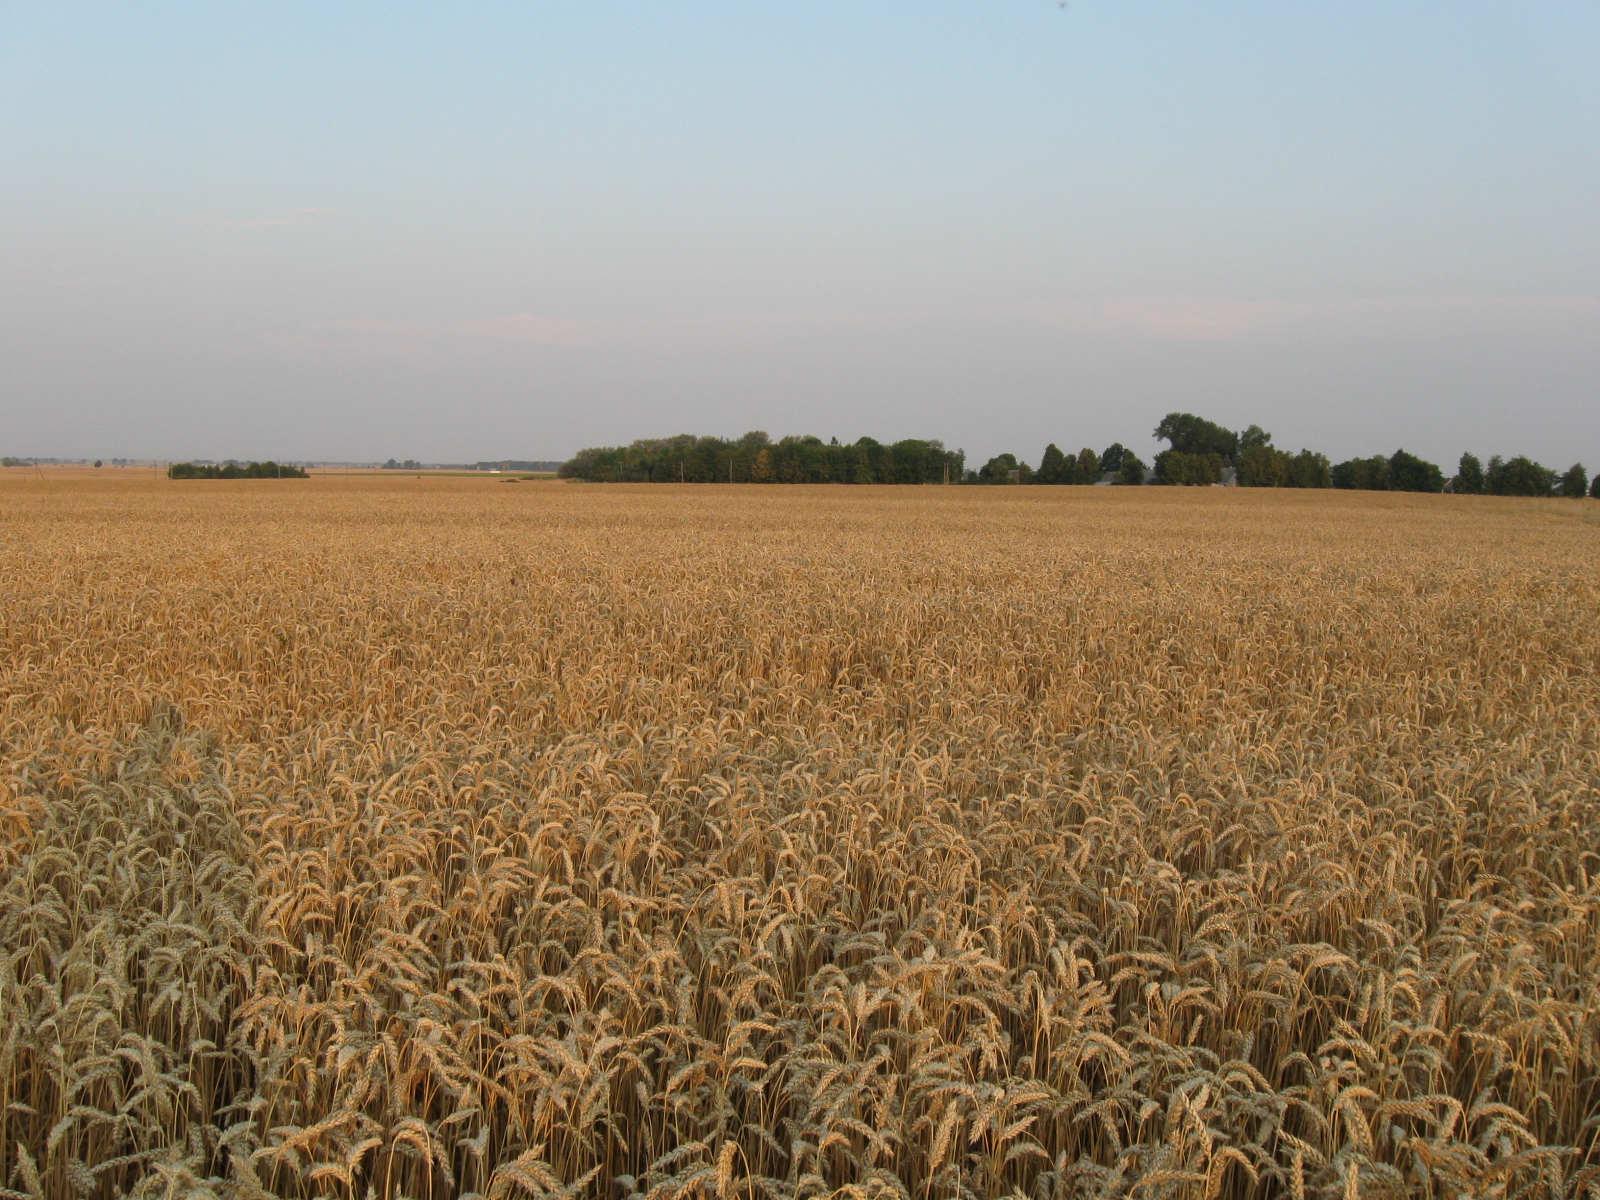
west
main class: Cropland
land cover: Common wheat
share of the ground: > 75 %
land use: Agriculture (excluding fallow land and kitchen gardens)
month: August
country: LT
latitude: 54.5431
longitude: 23.2942
